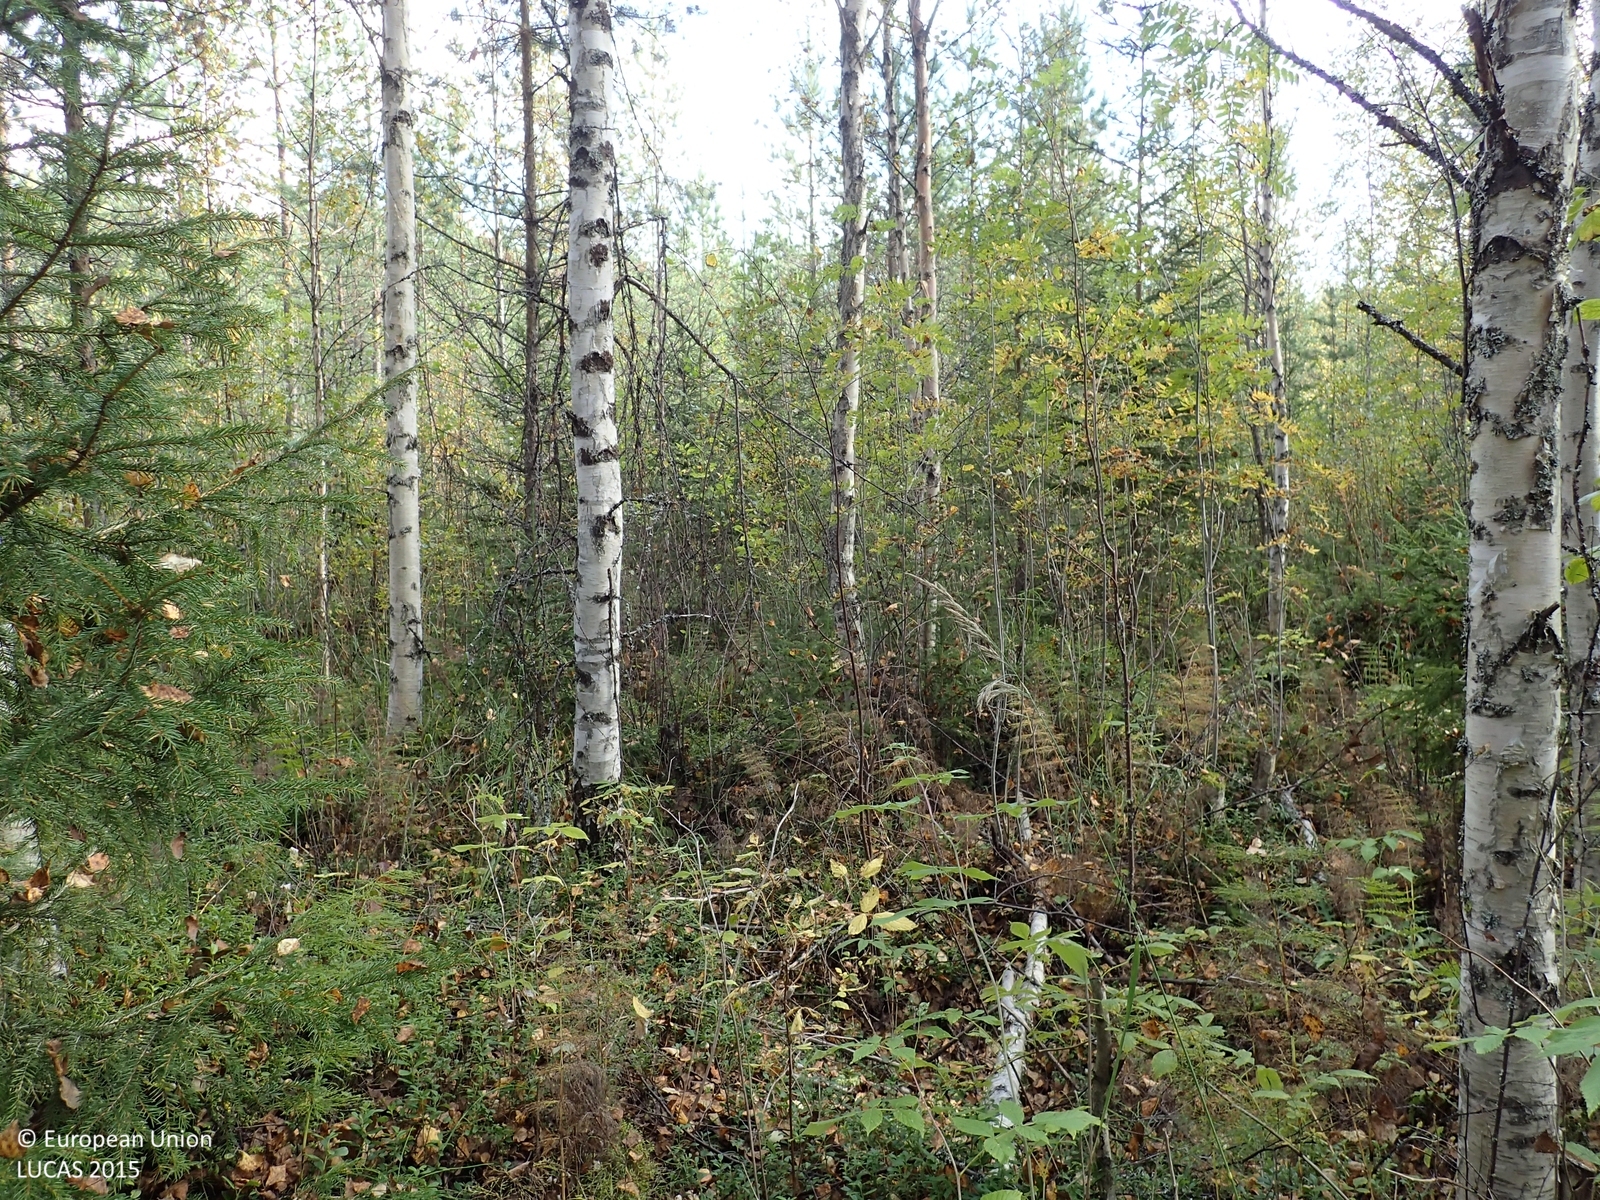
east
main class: Woodland
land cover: Broadleaved woodland
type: non-riverine alder, birch or aspen forest
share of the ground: > 75 %
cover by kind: broadleaved forest trees 70 %, herbaceous plants 15 %, coniferous forest trees 5 %, shrubs 5 %, lichens and mosses 5 %
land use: Forestry
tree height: > 5 m
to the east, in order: Broadleaved woodland; Ditches and canals; Broadleaved woodland; Ditches and canals; Pine dominated mixed woodland; Ditches and canals; Pine dominated mixed woodland; Ditches and canals; Pine dominated mixed woodland; Pine dominated coniferous woodland; Pine dominated mixed woodland
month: September
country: FI
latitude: 62.9464
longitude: 25.4989
